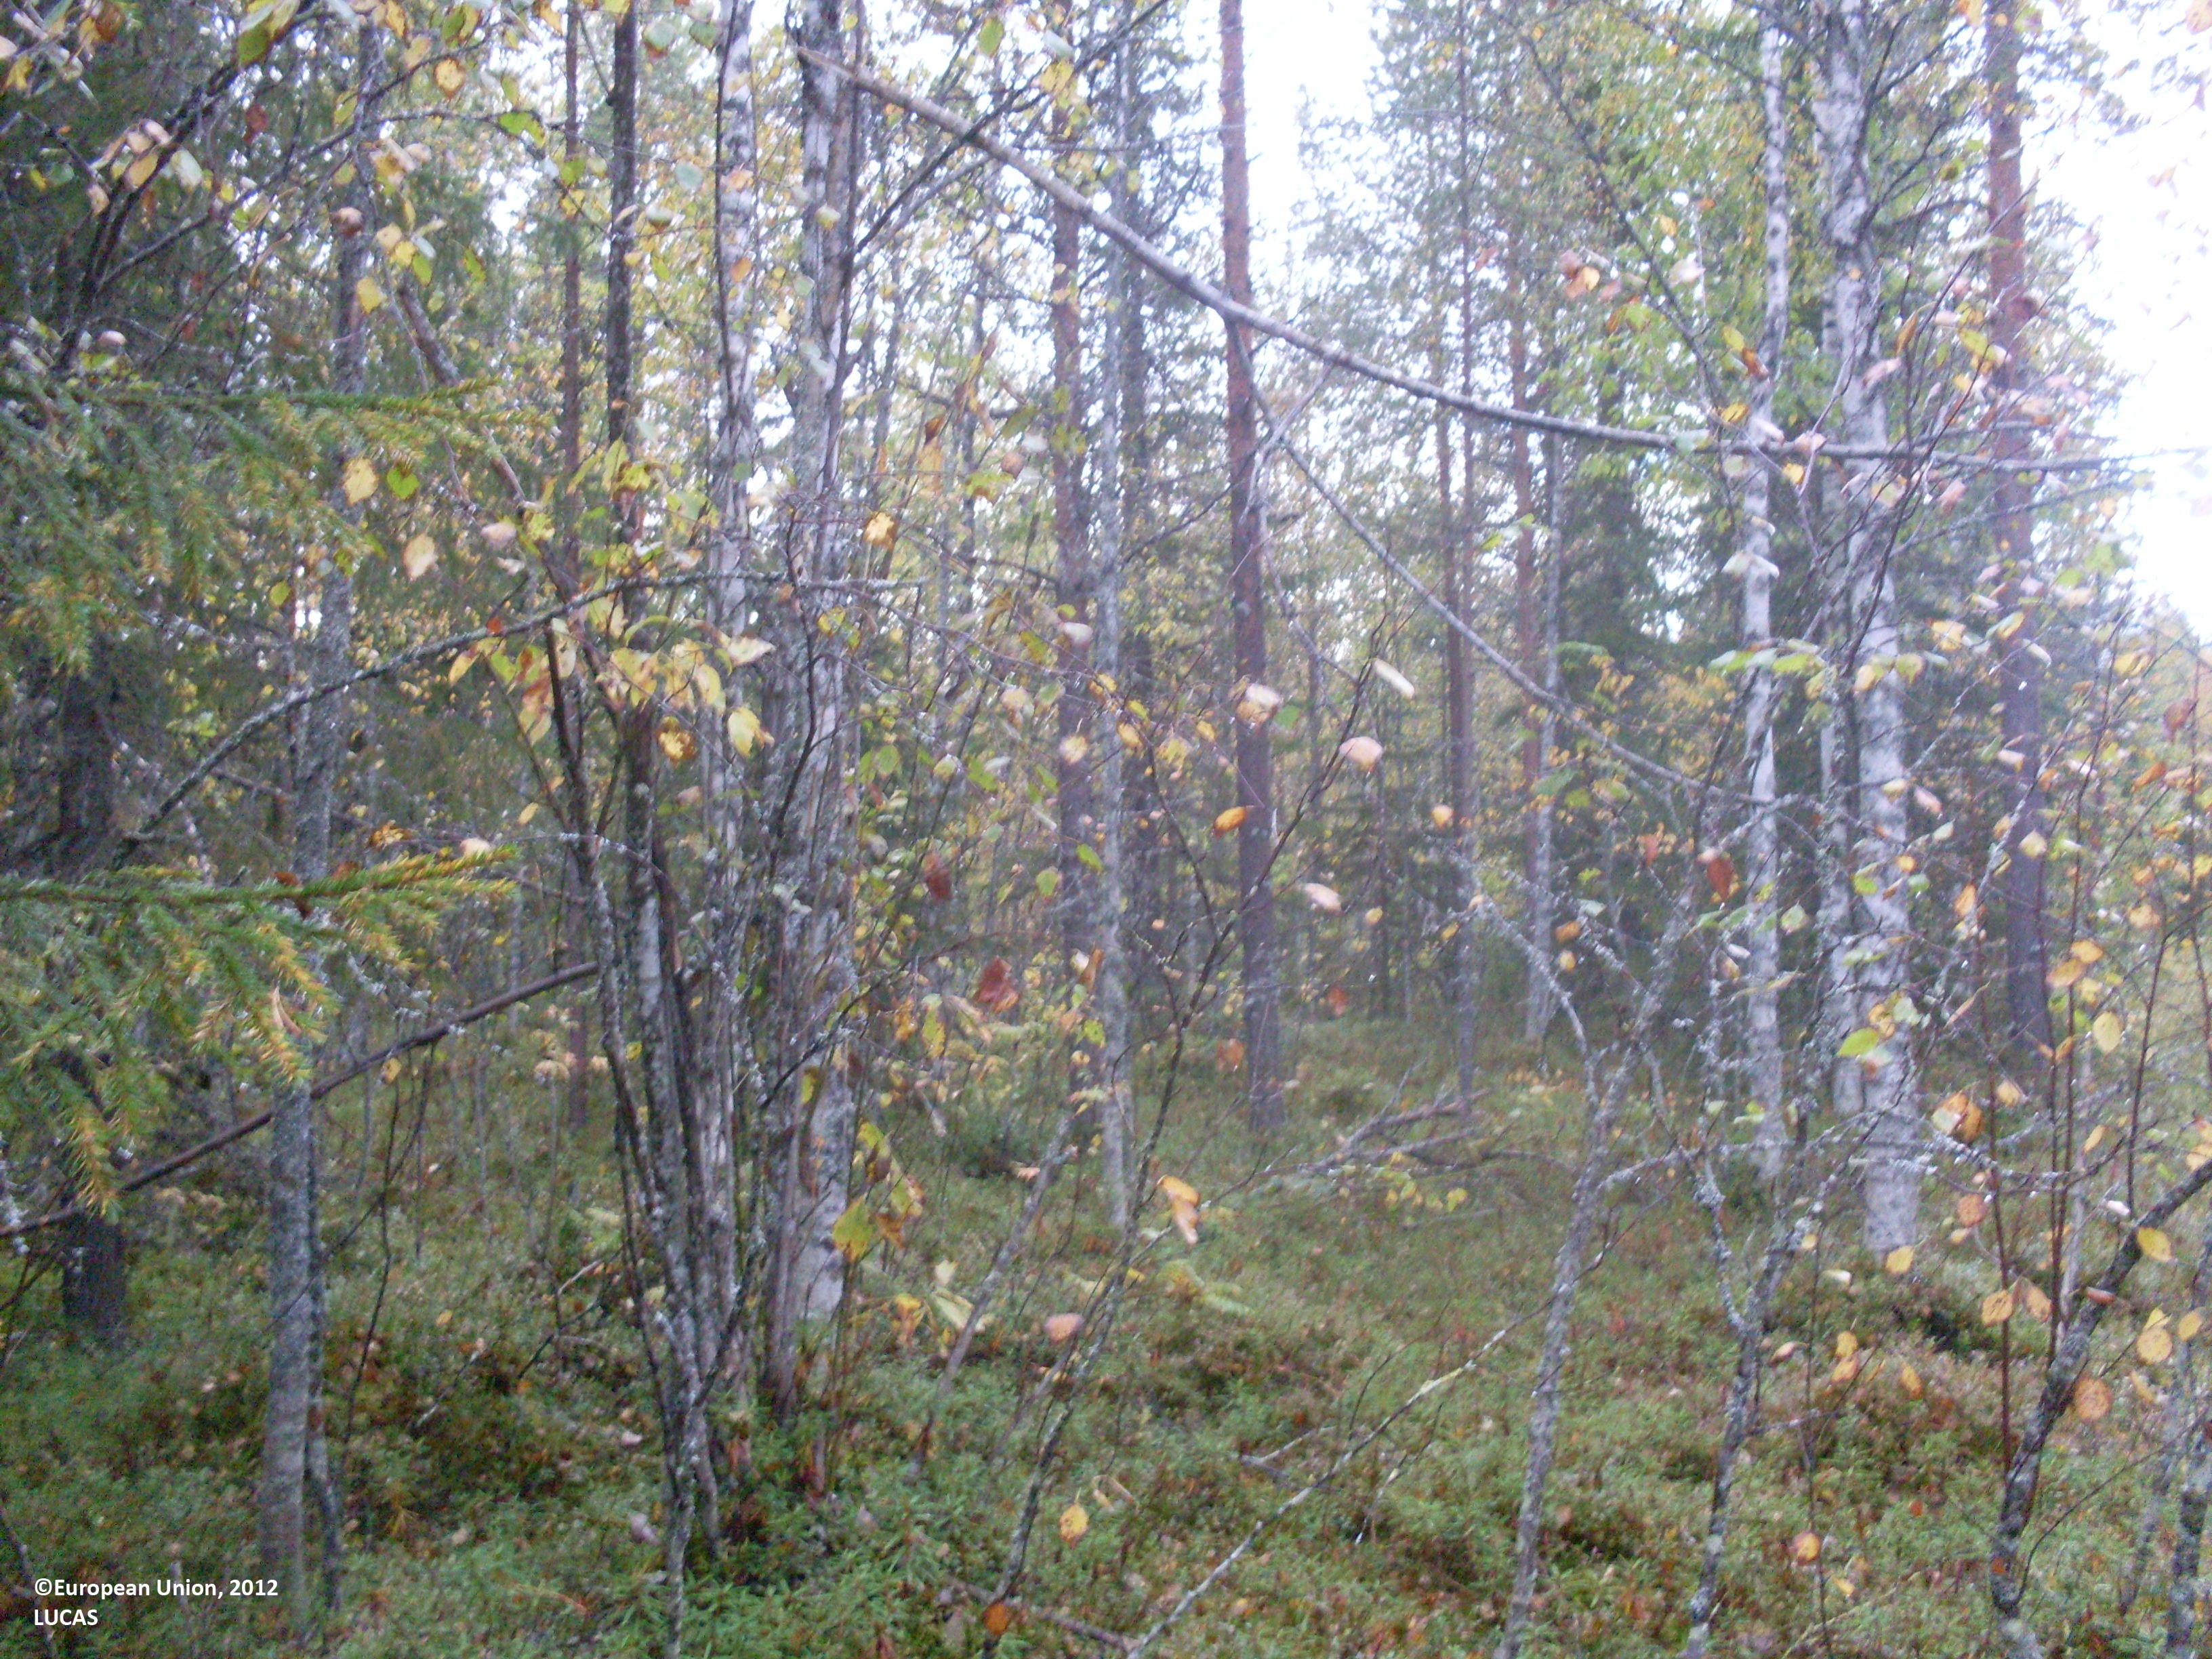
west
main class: Woodland
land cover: Other mixed woodland
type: boreal forest
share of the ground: > 75 %
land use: Forestry
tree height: > 5 m
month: September
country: FI
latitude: 64.0336
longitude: 29.9088
